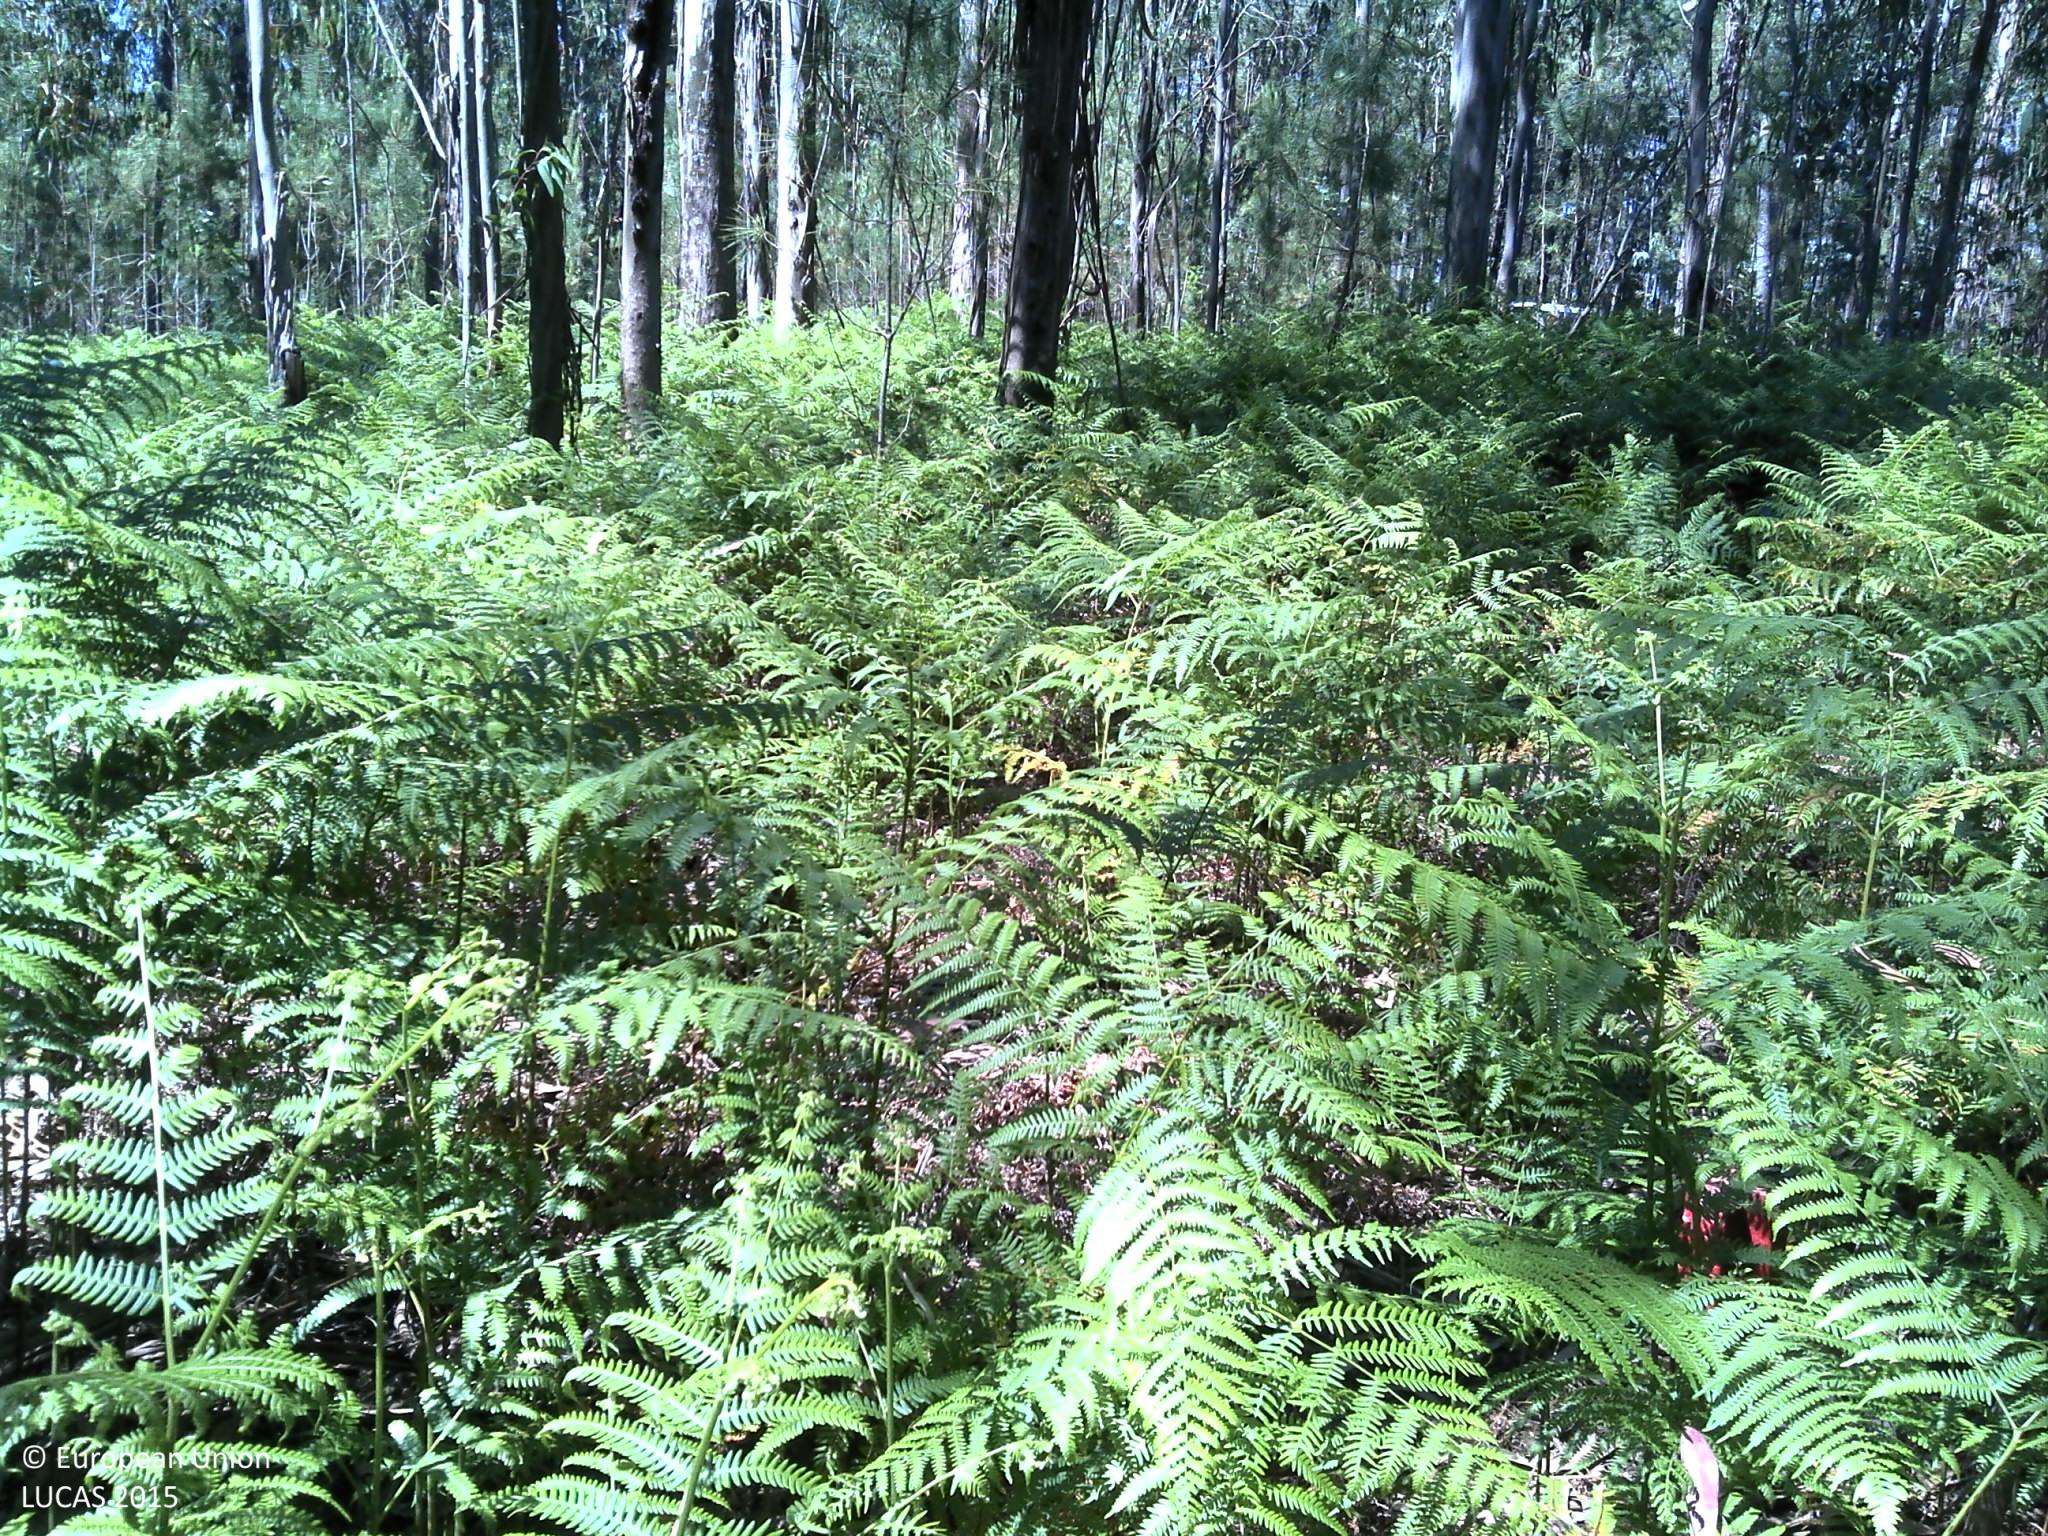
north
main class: Woodland
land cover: Broadleaved woodland
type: exotic forest
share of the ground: 50 - 75 %
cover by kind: broadleaved forest trees 65 %, shrubs 30 %, coniferous forest trees 5 %
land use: Forestry
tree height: > 5 m
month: May
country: PT
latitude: 41.6713
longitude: -8.5982
